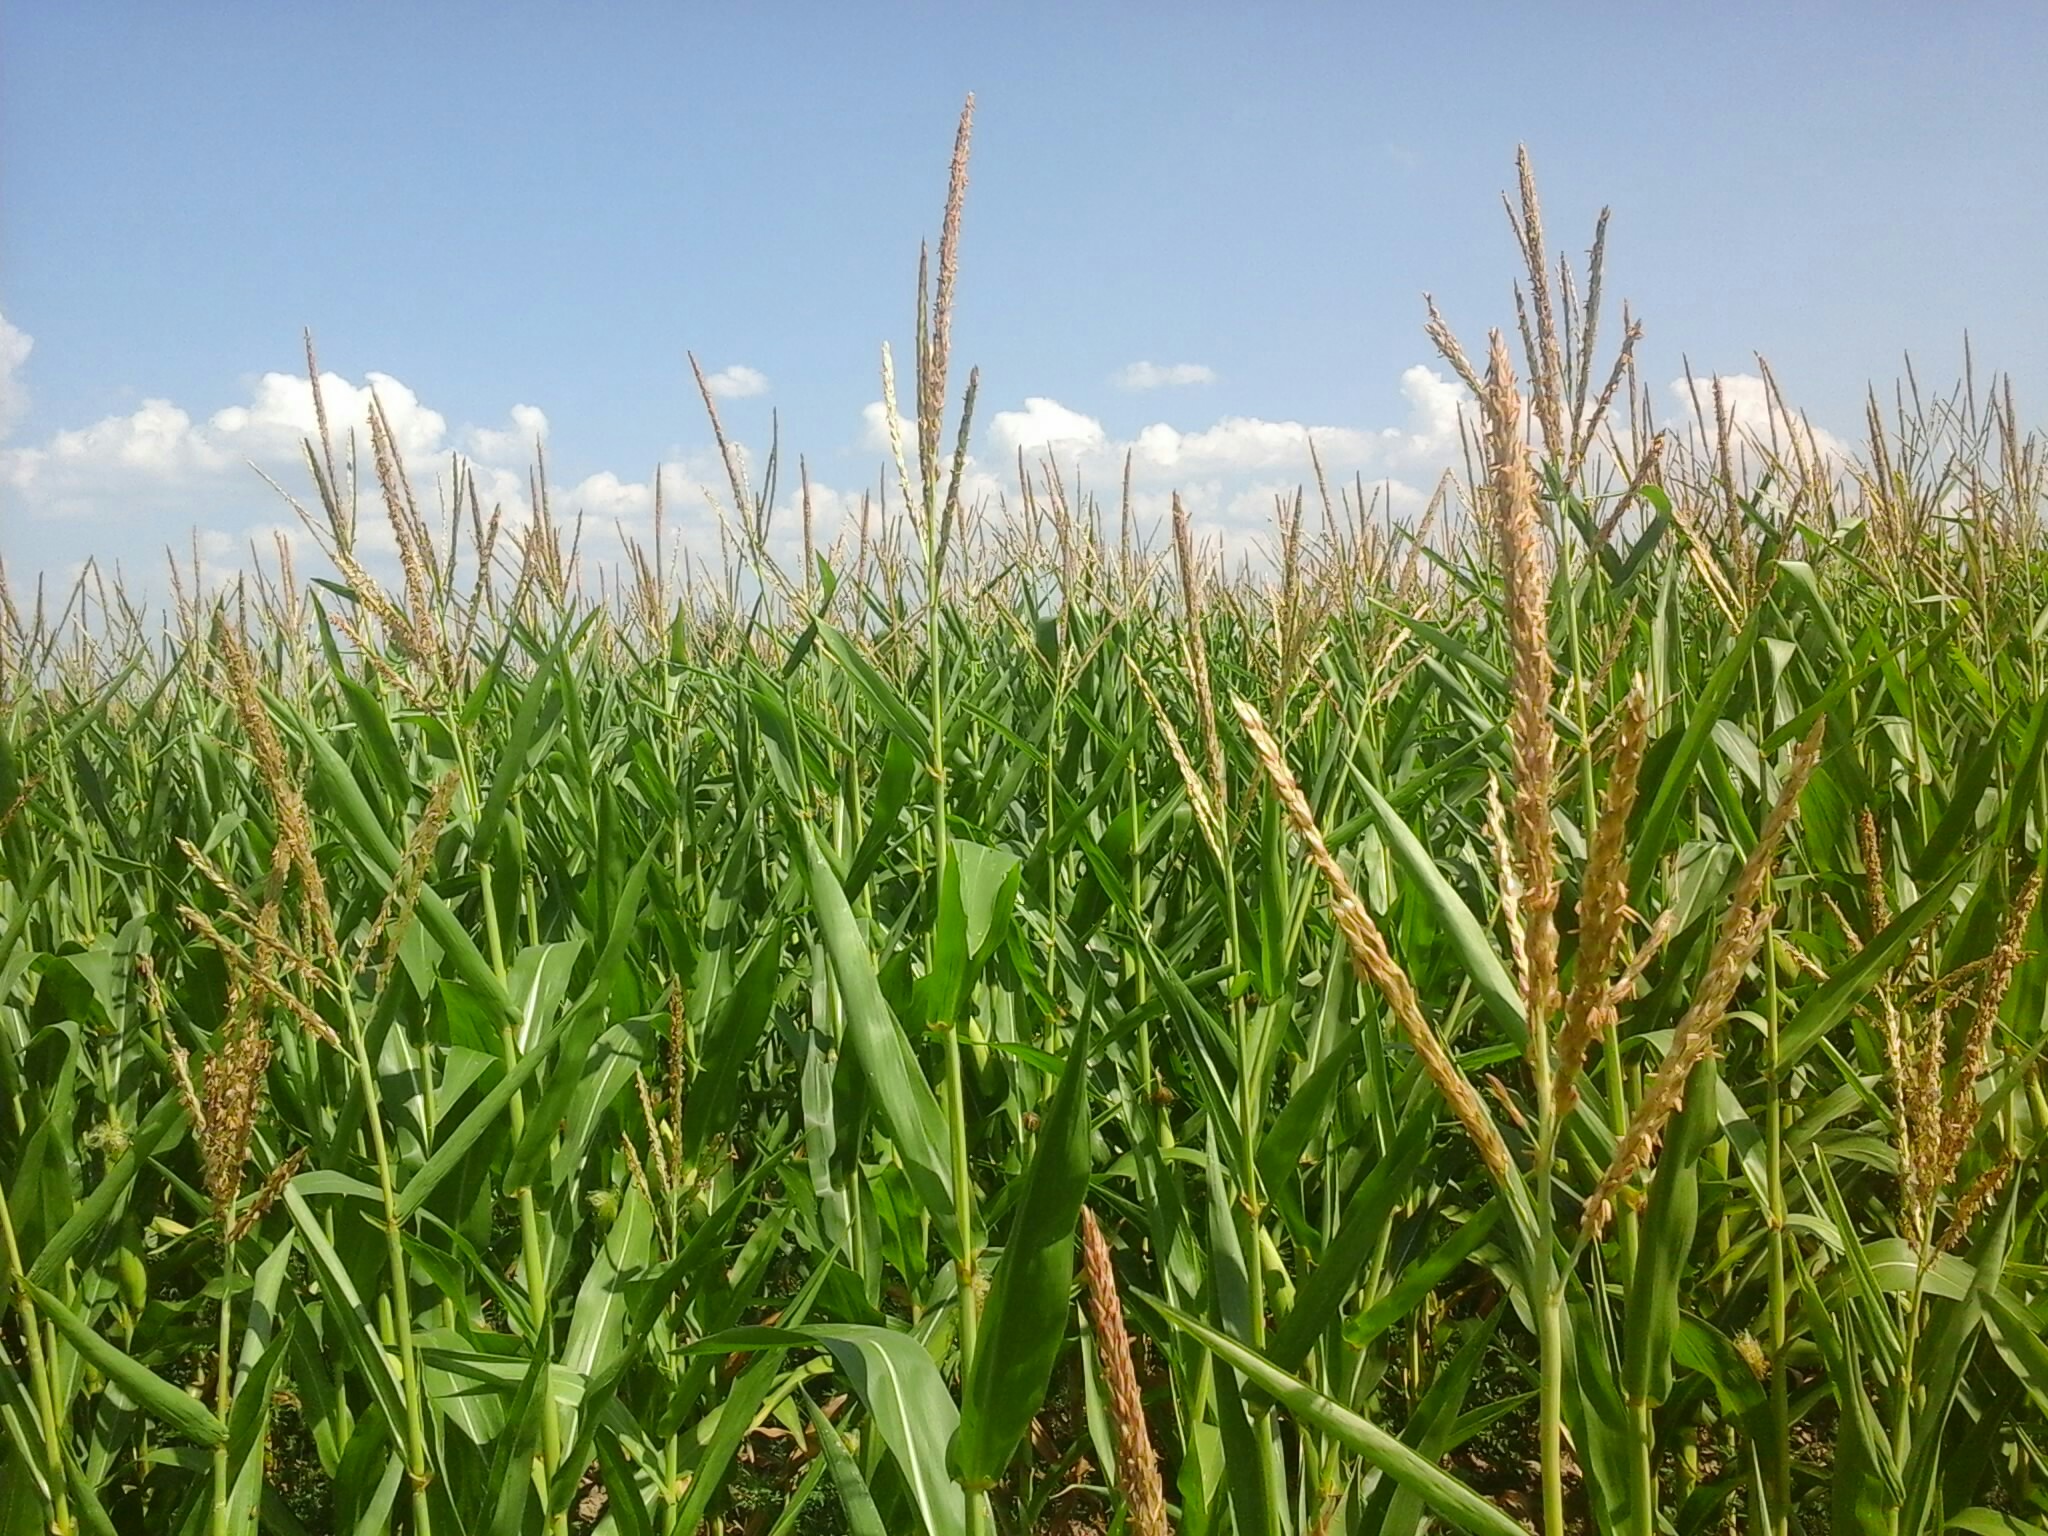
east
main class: Cropland
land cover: Maize
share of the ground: > 75 %
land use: Agriculture (excluding fallow land and kitchen gardens)
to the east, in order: Maize; Grass margins; Oats
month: August
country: HU
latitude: 47.4775
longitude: 18.0390
